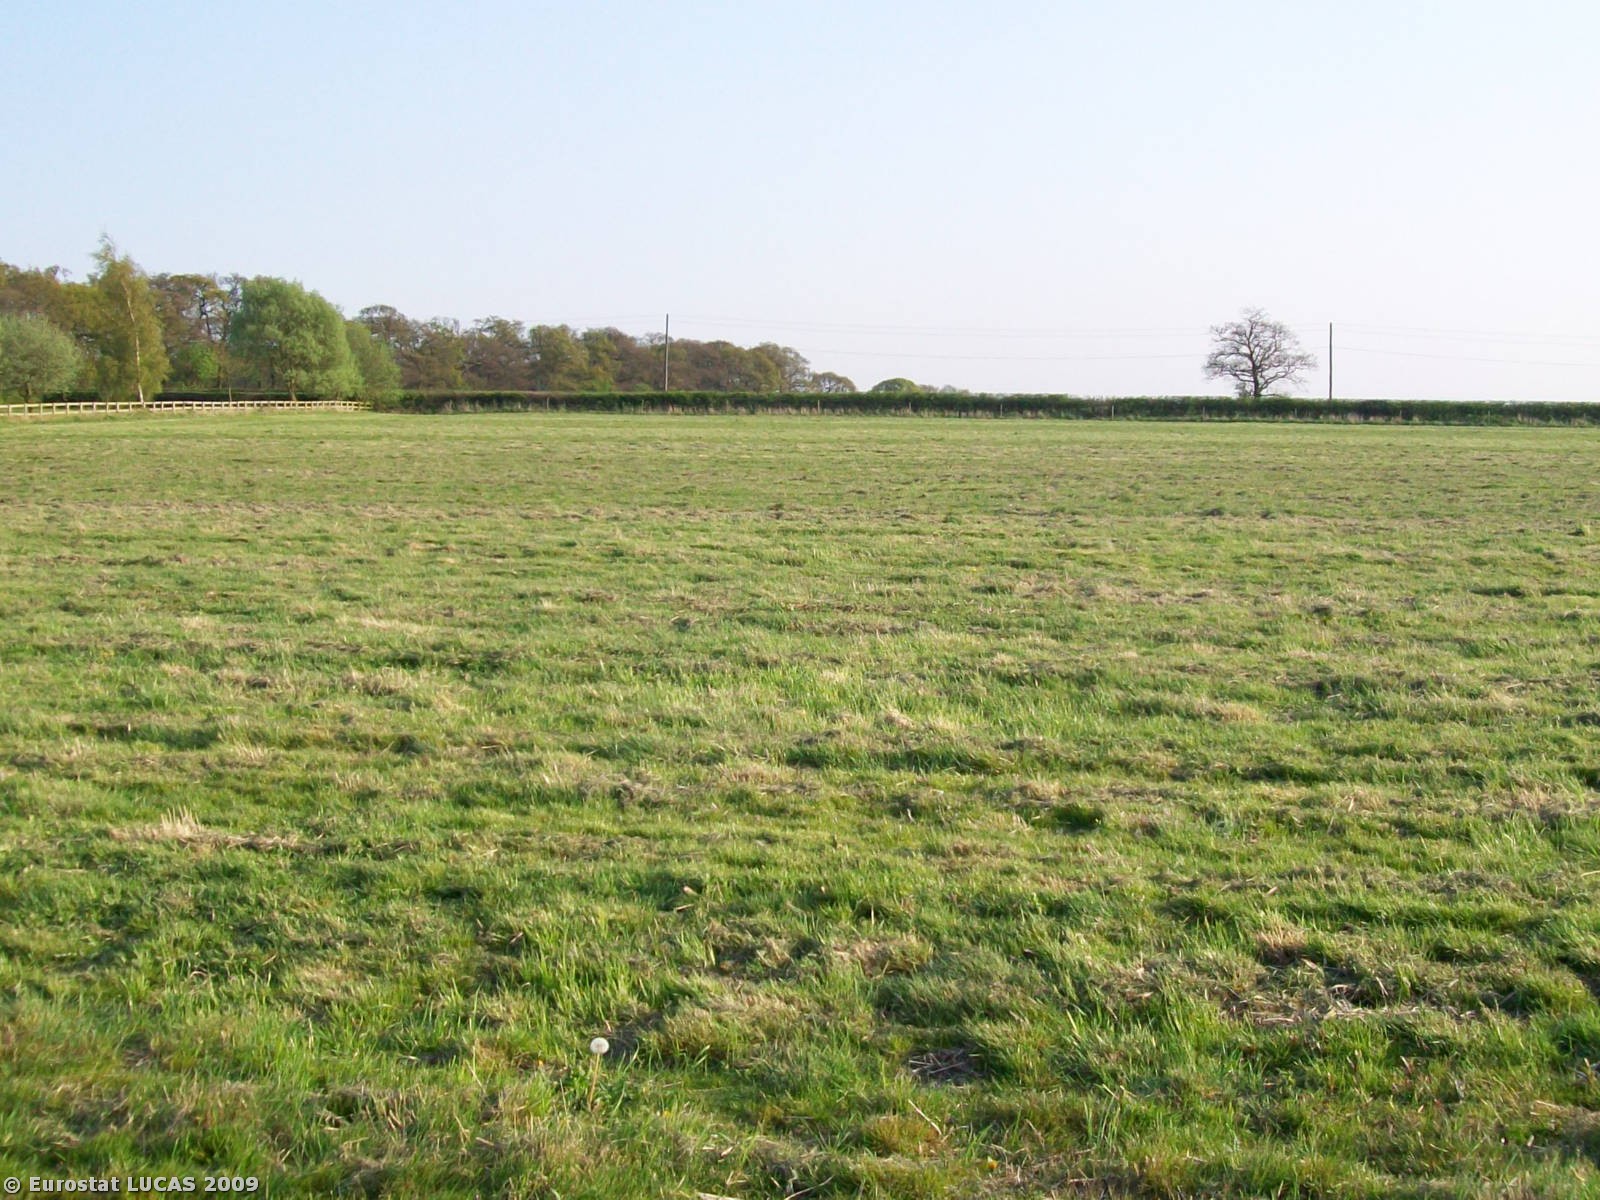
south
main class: Grassland
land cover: Grassland without tree/shrub cover
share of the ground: > 75 %
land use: Agriculture (excluding fallow land and kitchen gardens)
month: April
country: GB
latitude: 52.9518
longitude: -1.4058
